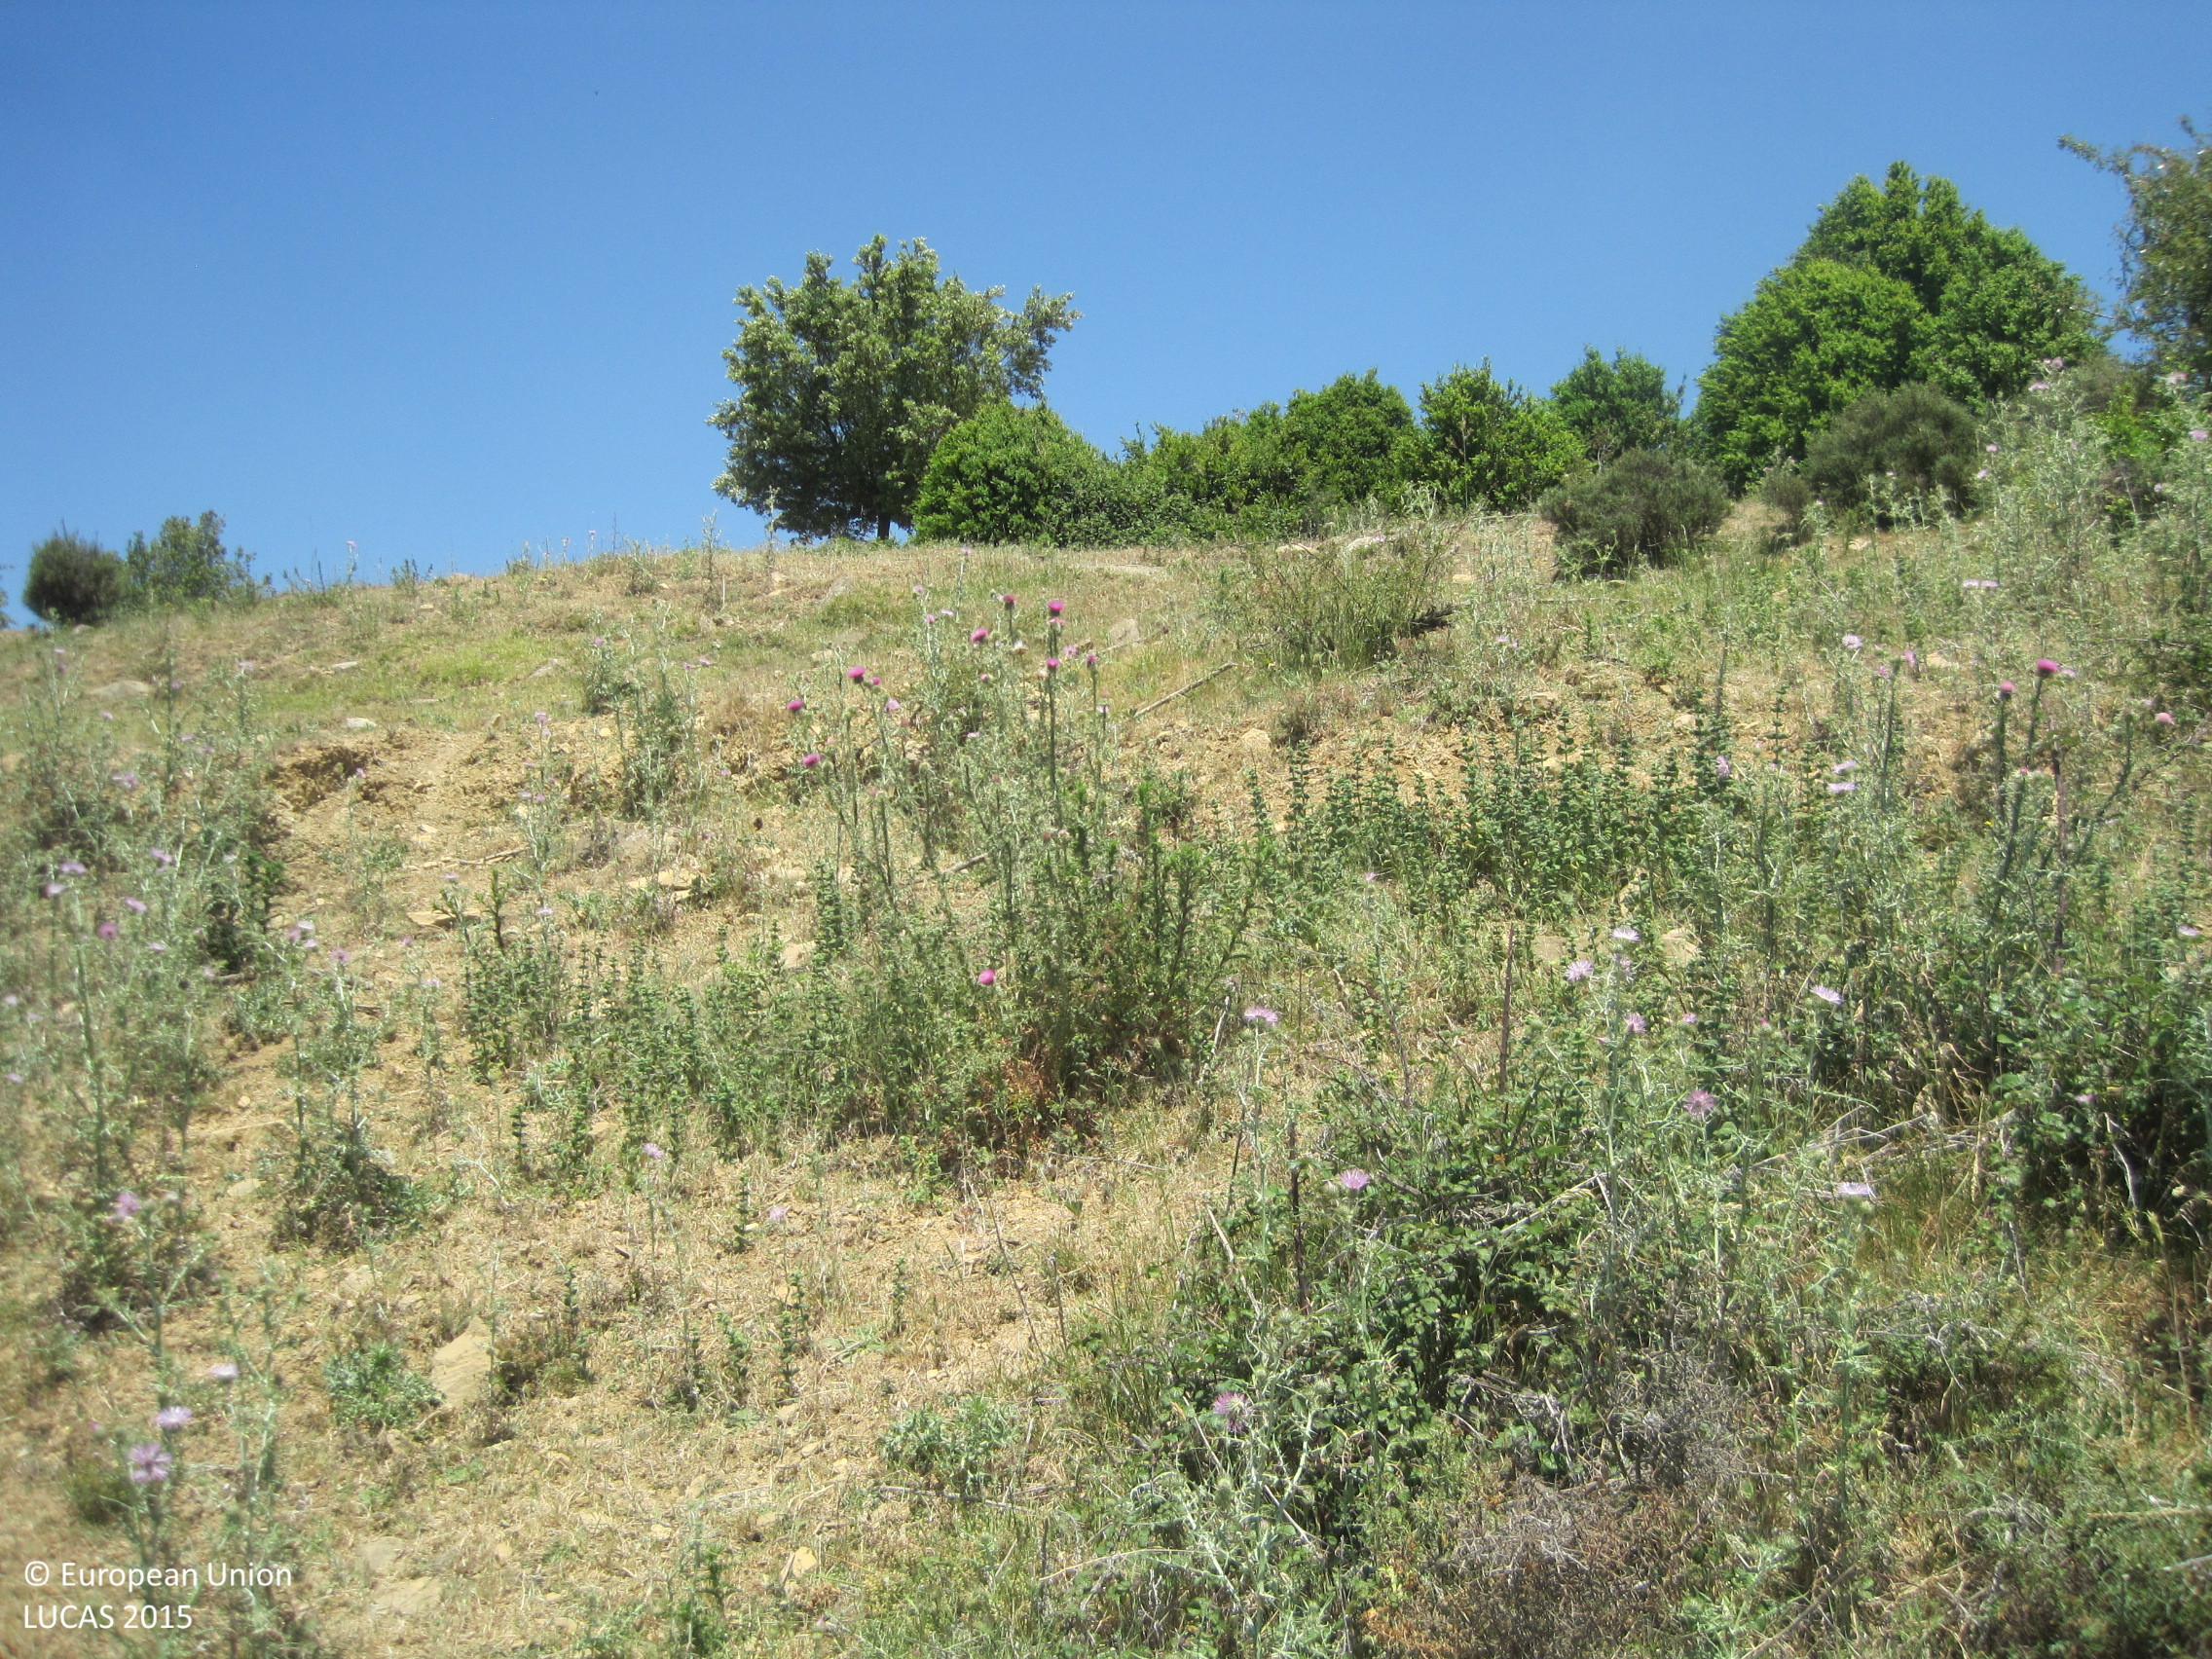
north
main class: Grassland
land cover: Grassland without tree/shrub cover
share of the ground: > 75 %
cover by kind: herbaceous plants 50 %, unconsolidated bare surface 45 %, shrubs 5 %
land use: Agriculture (excluding fallow land and kitchen gardens)
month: June
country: ES
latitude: 42.6771
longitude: -1.4457
